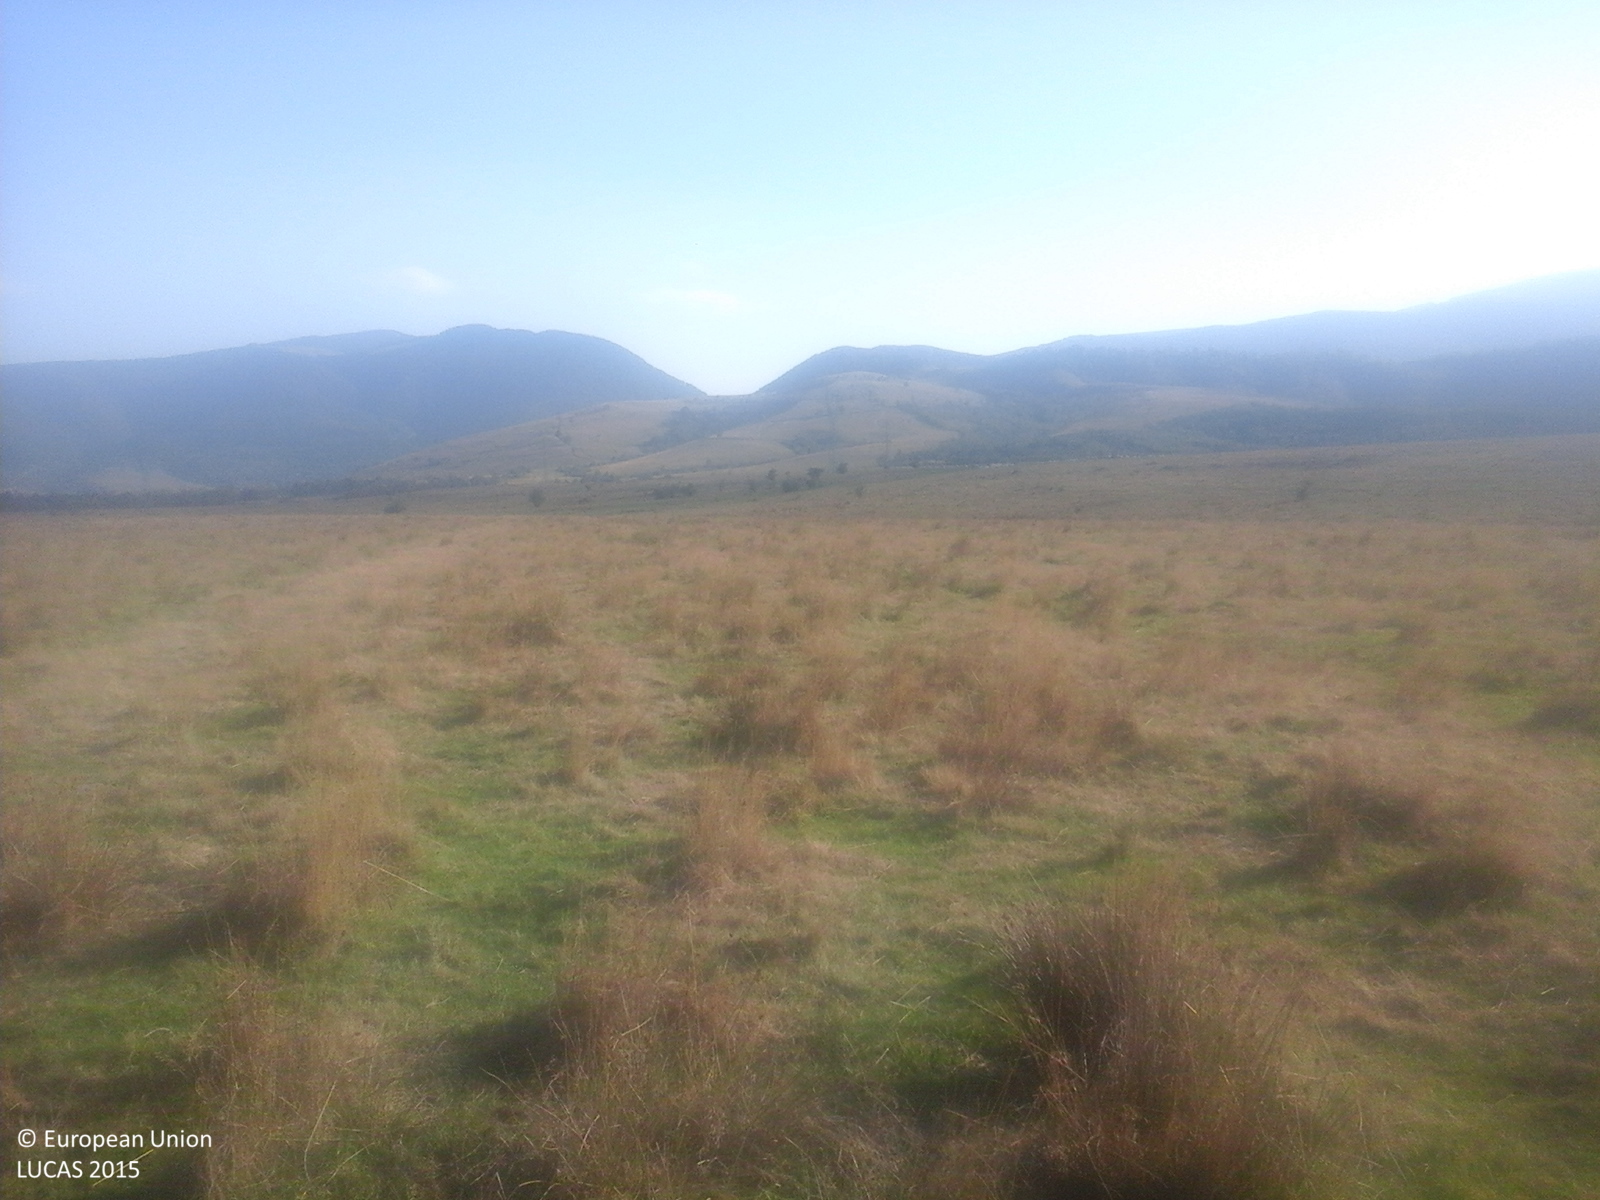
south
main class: Grassland
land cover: Grassland without tree/shrub cover
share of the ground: > 75 %
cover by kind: herbaceous plants 100 %
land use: Agriculture (excluding fallow land and kitchen gardens)
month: September
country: RO
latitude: 45.4909
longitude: 23.0669
